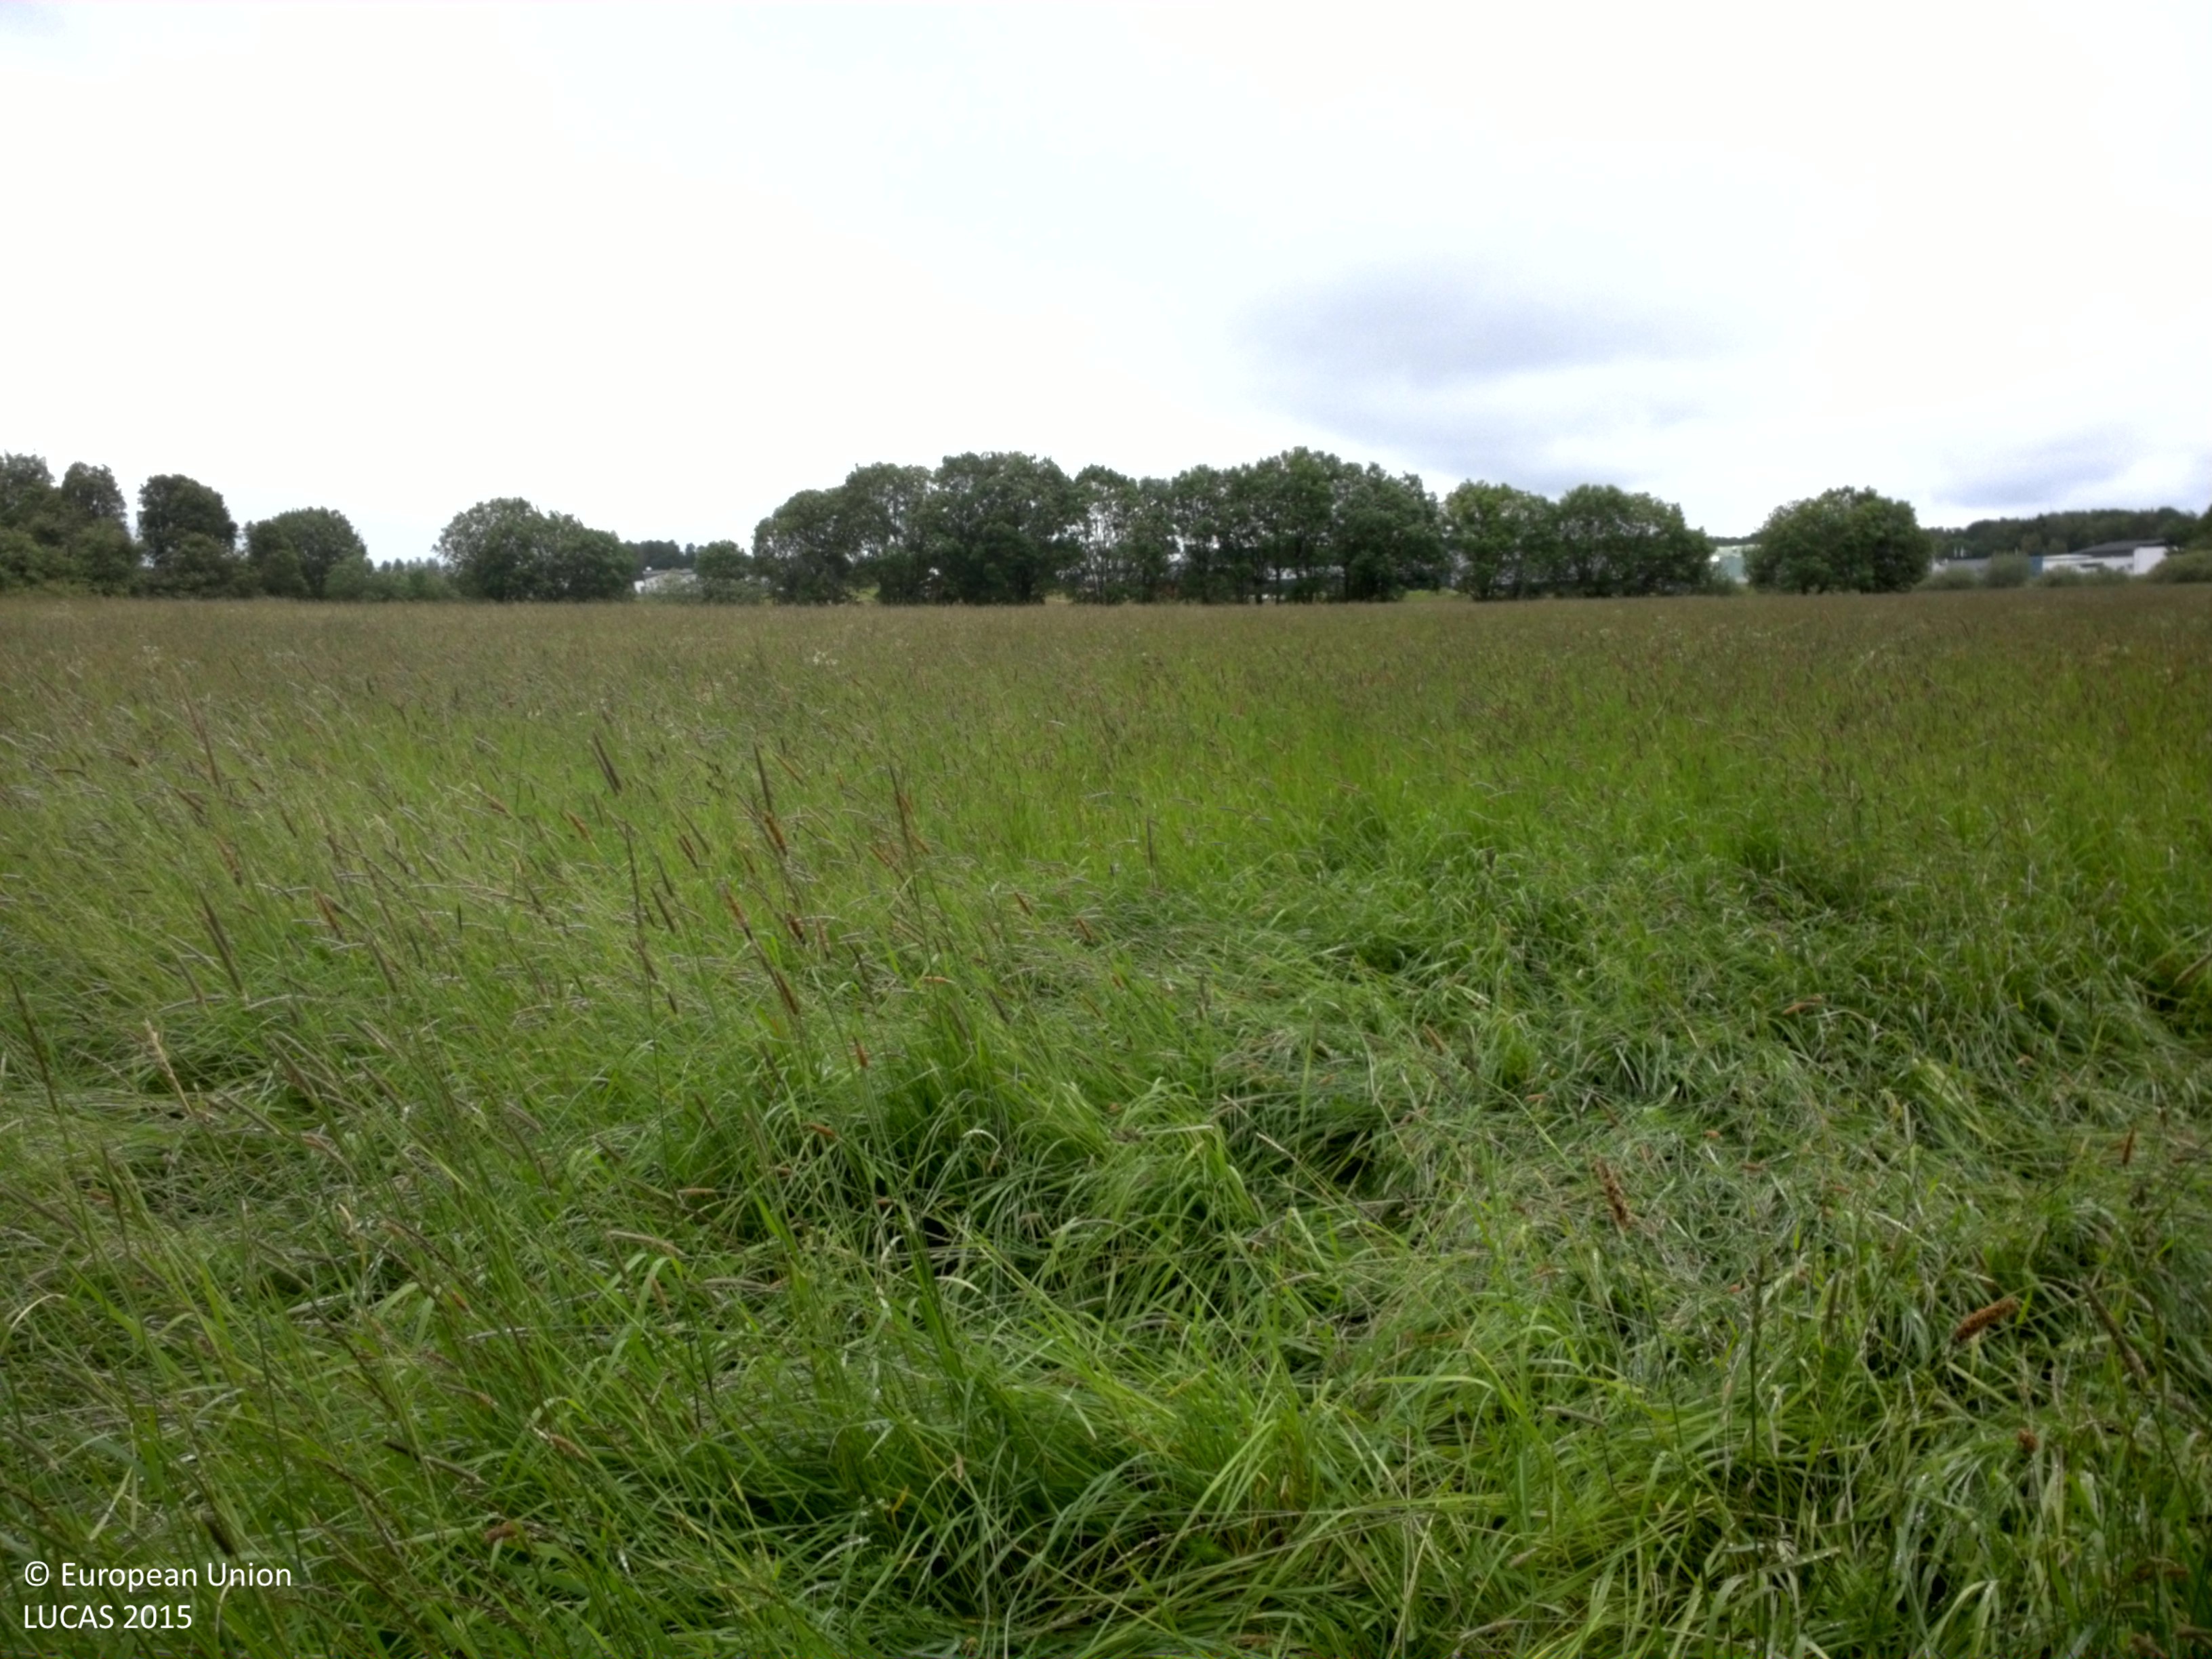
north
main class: Cropland
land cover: Other leguminous and mixtures for fodder
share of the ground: > 75 %
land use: Agriculture (excluding fallow land and kitchen gardens)
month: June
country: SE
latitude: 59.7306
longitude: 18.6973
